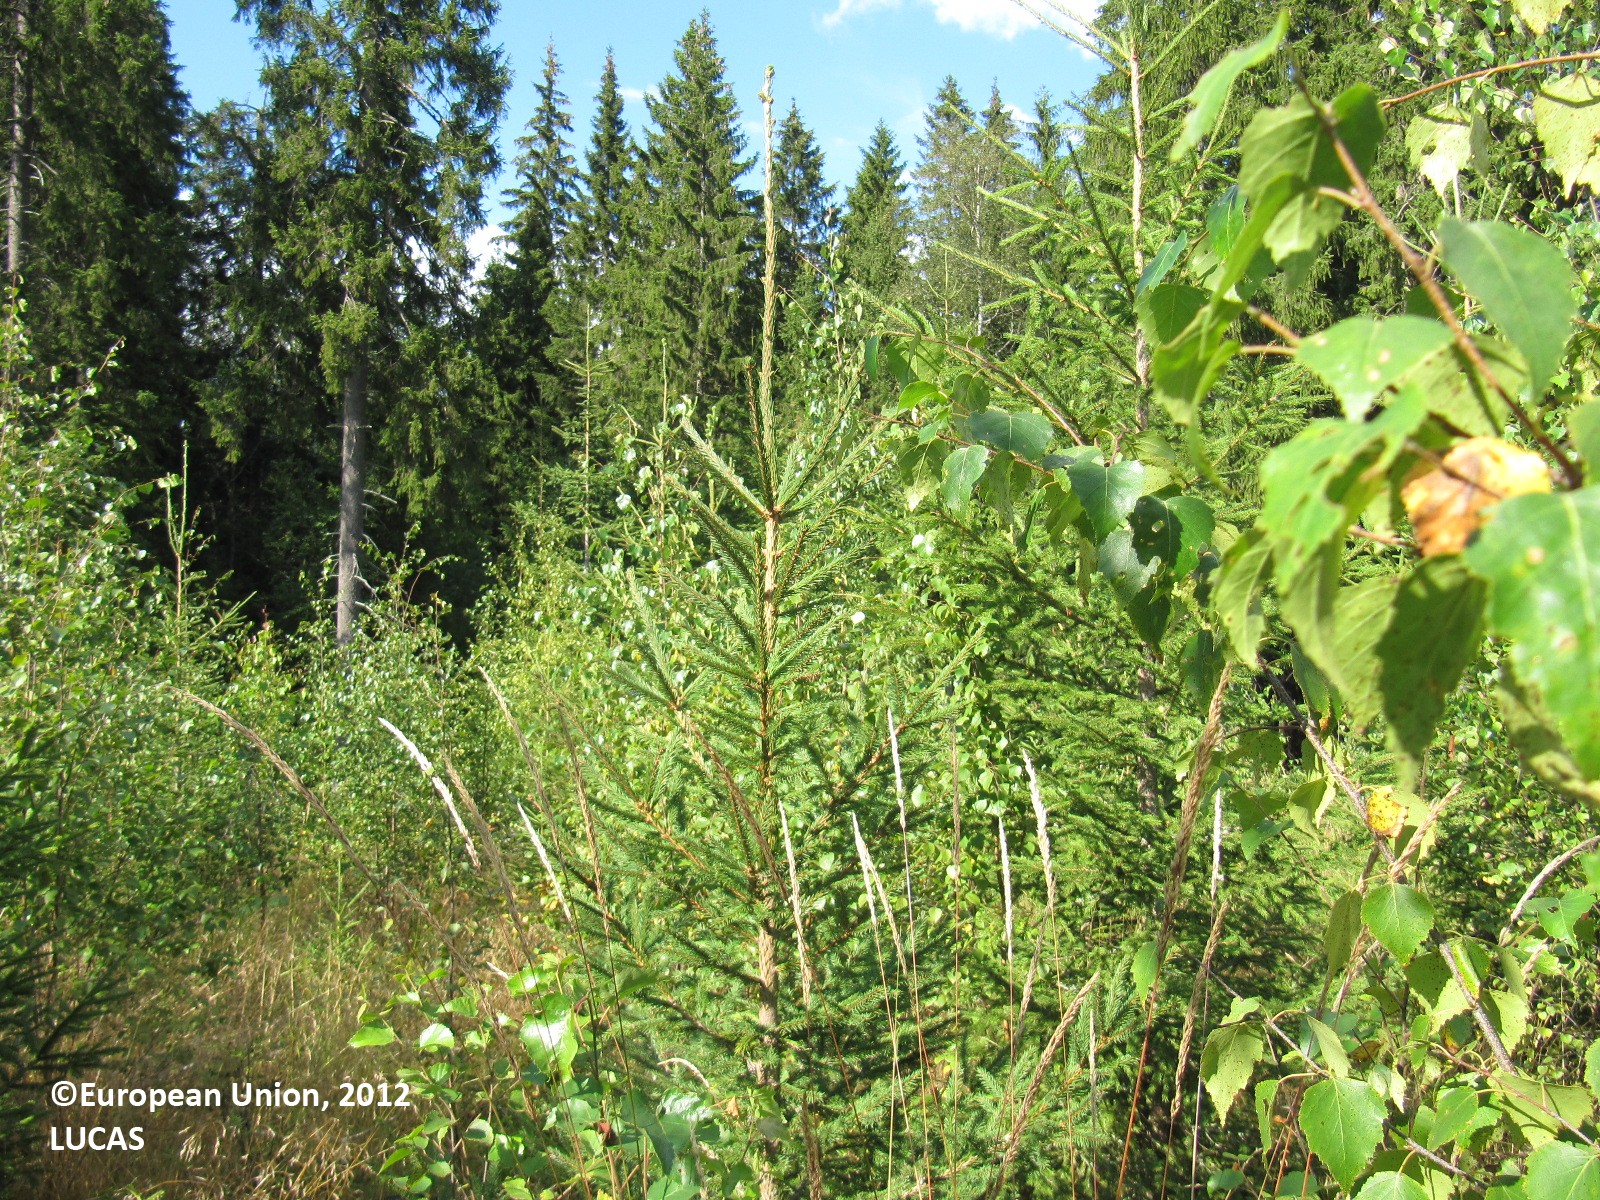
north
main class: Woodland
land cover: Other mixed woodland
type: boreal forest
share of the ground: > 75 %
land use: Forestry
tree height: < 5 m
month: August
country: FI
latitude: 60.6267
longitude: 24.6011
